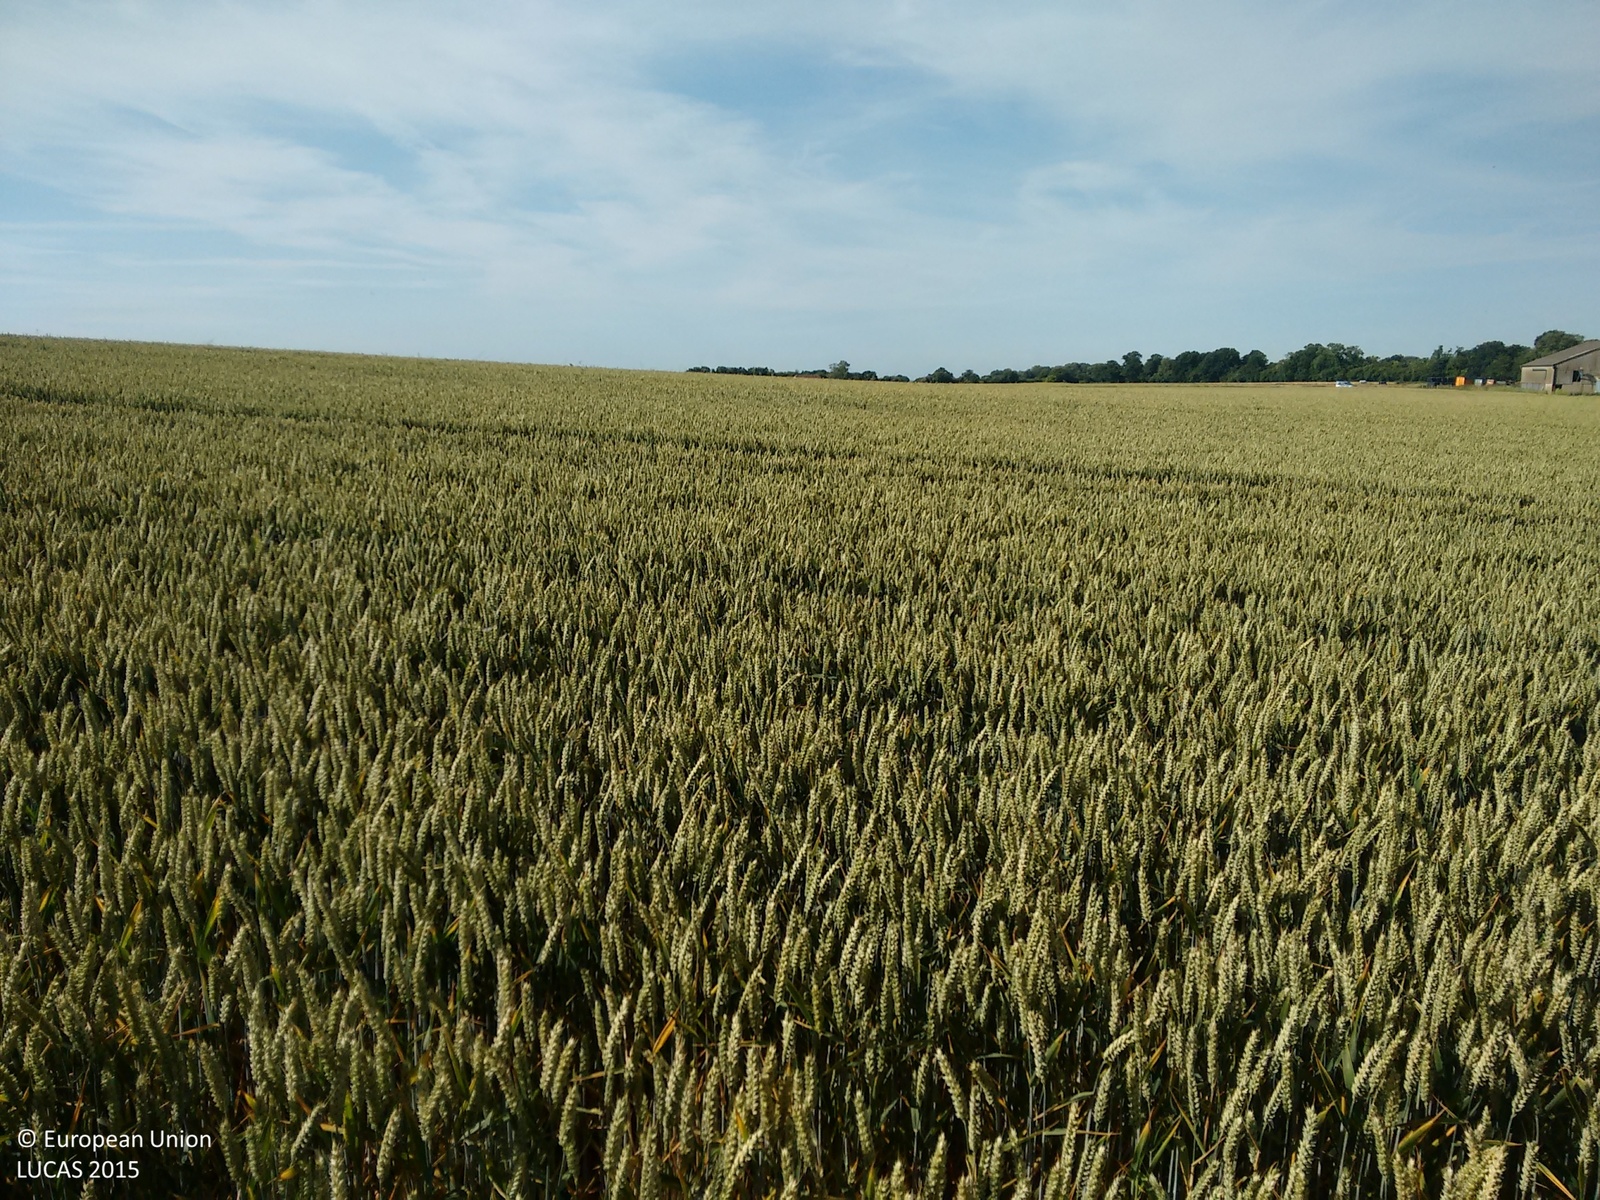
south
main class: Cropland
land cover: Common wheat
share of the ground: 50 - 75 %
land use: Agriculture (excluding fallow land and kitchen gardens)
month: July
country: GB
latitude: 50.8771
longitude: -0.8867
